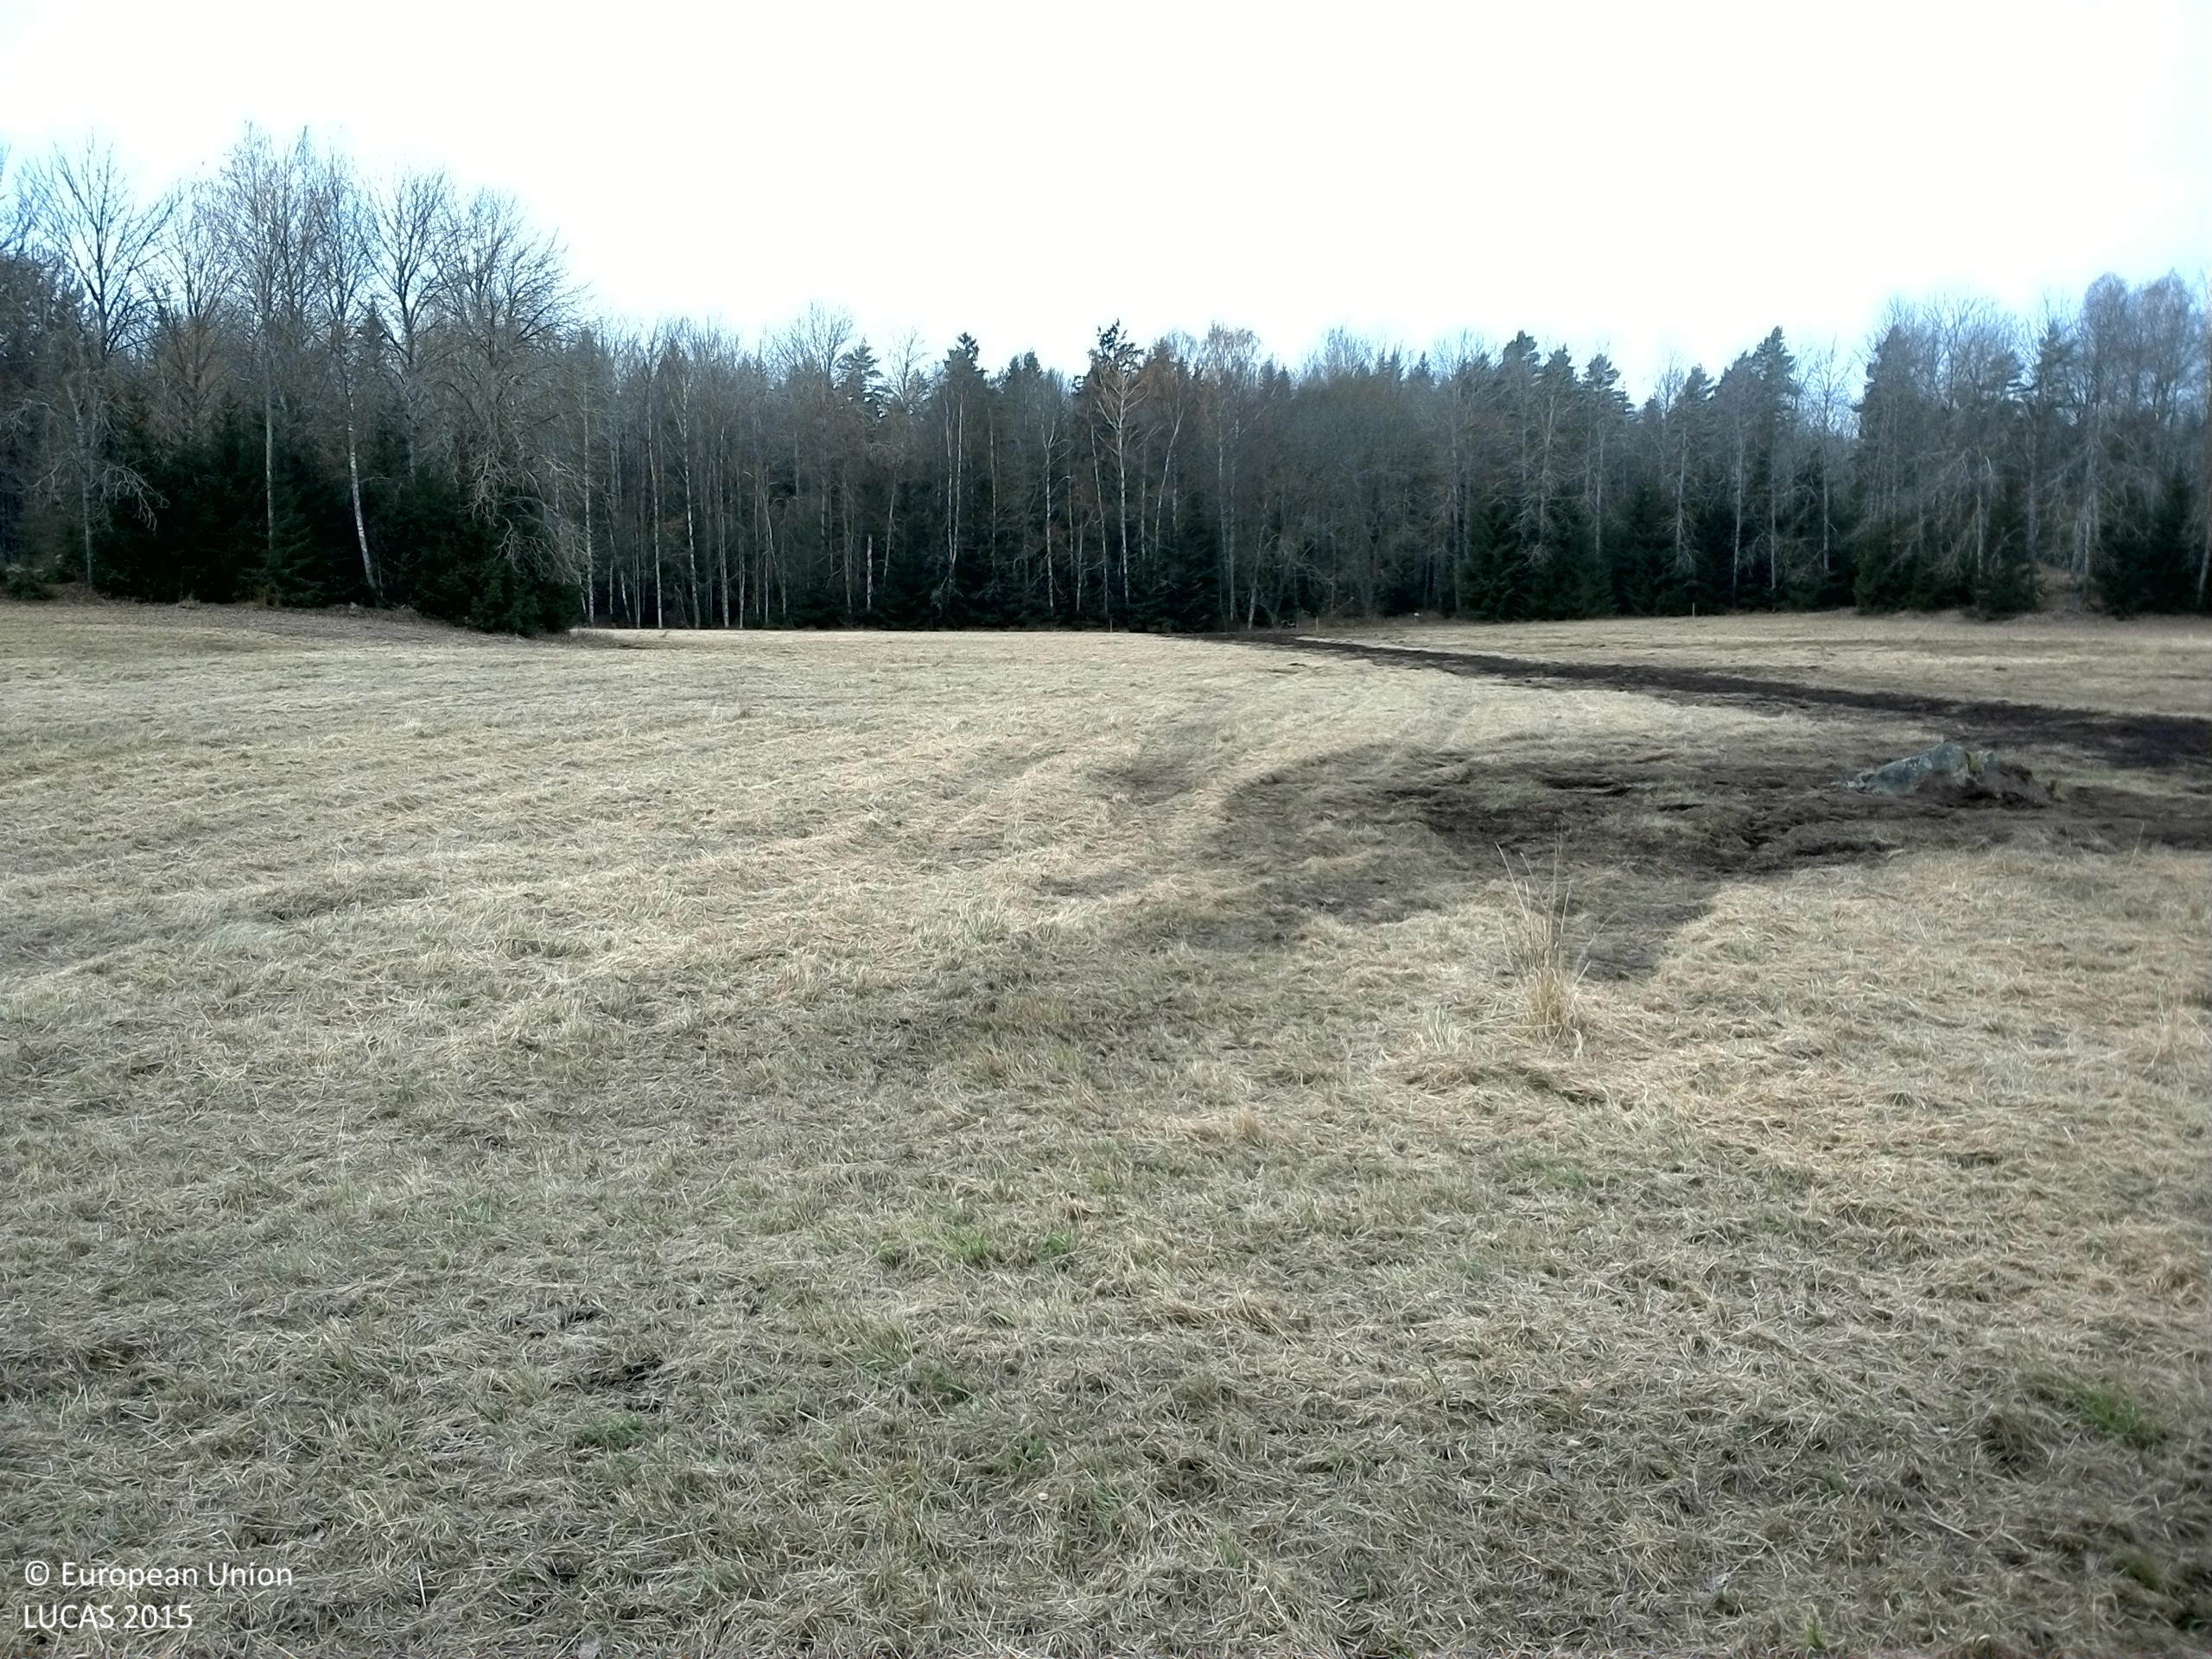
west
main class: Grassland
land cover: Grassland without tree/shrub cover
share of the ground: > 75 %
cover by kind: herbaceous plants 100 %
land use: Agriculture (excluding fallow land and kitchen gardens)
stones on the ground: < 10 %
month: October
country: SE
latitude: 59.1372
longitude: 17.0386
